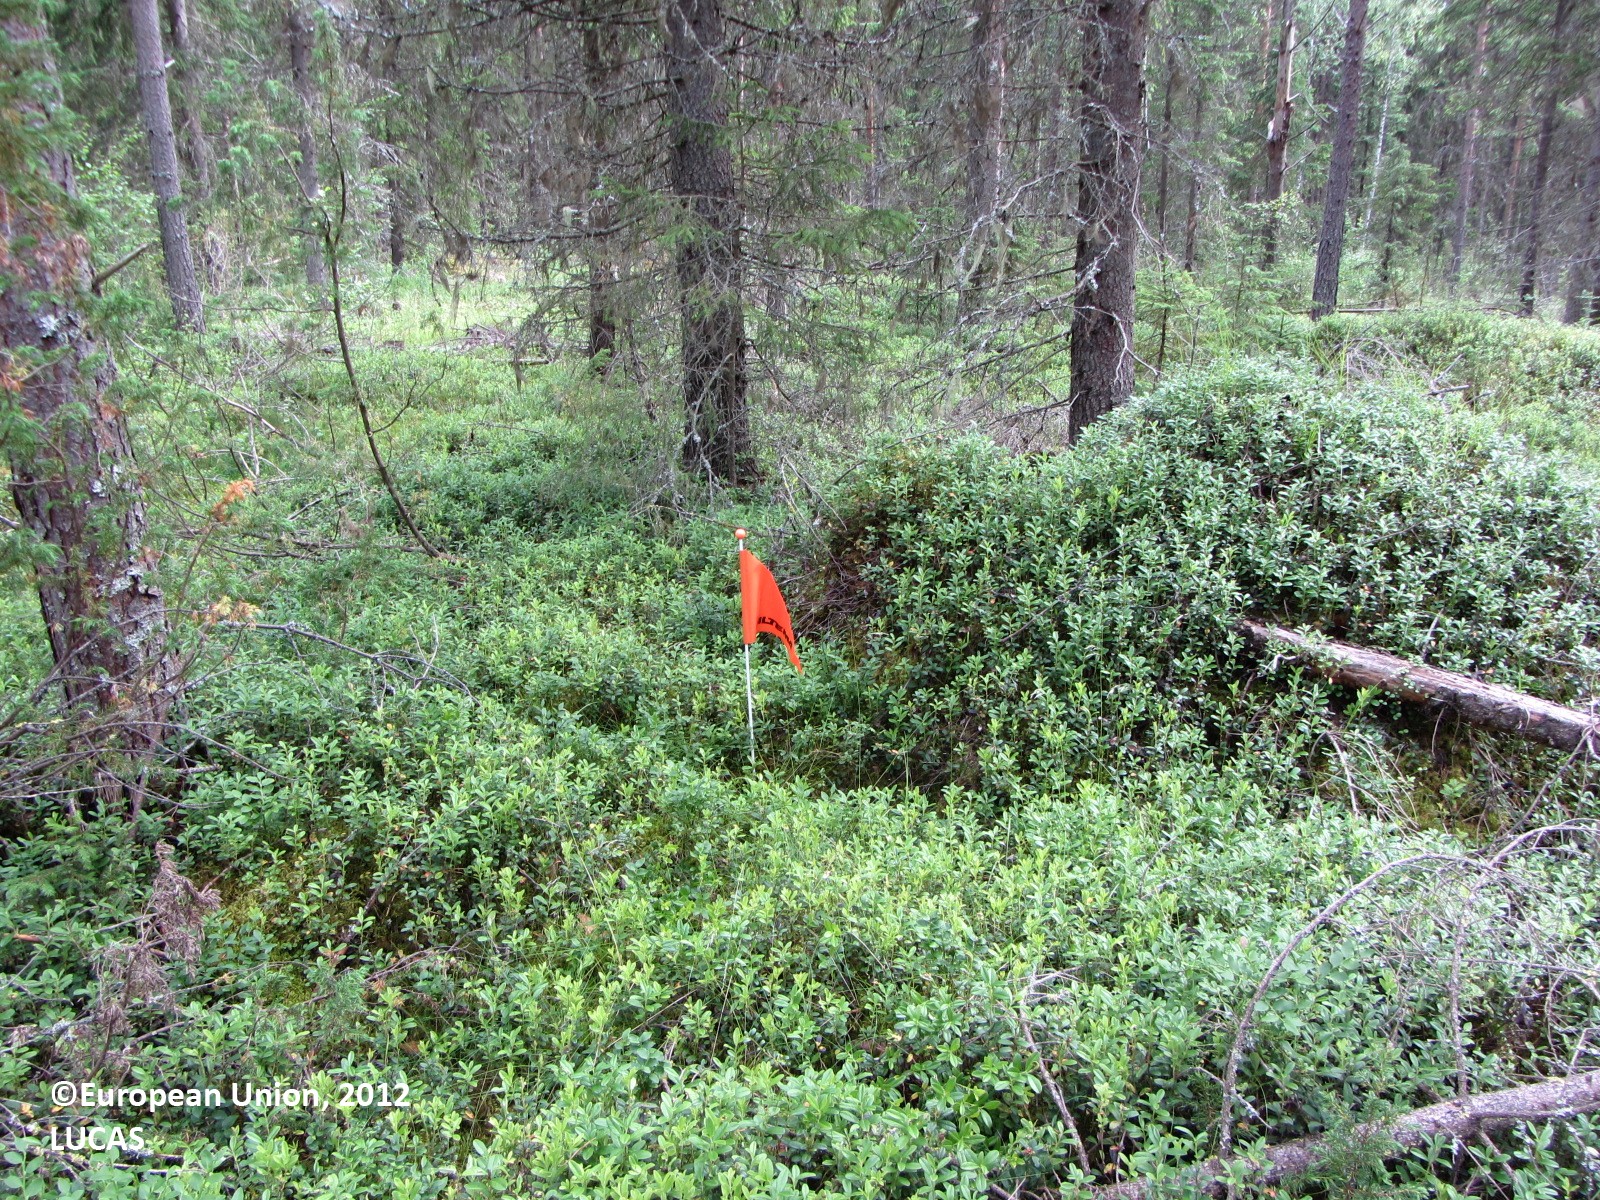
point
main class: Woodland
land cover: Other coniferous woodland
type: boreal forest
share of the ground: > 75 %
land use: Forestry
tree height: > 5 m
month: July
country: FI
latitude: 63.6945
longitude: 25.4078
